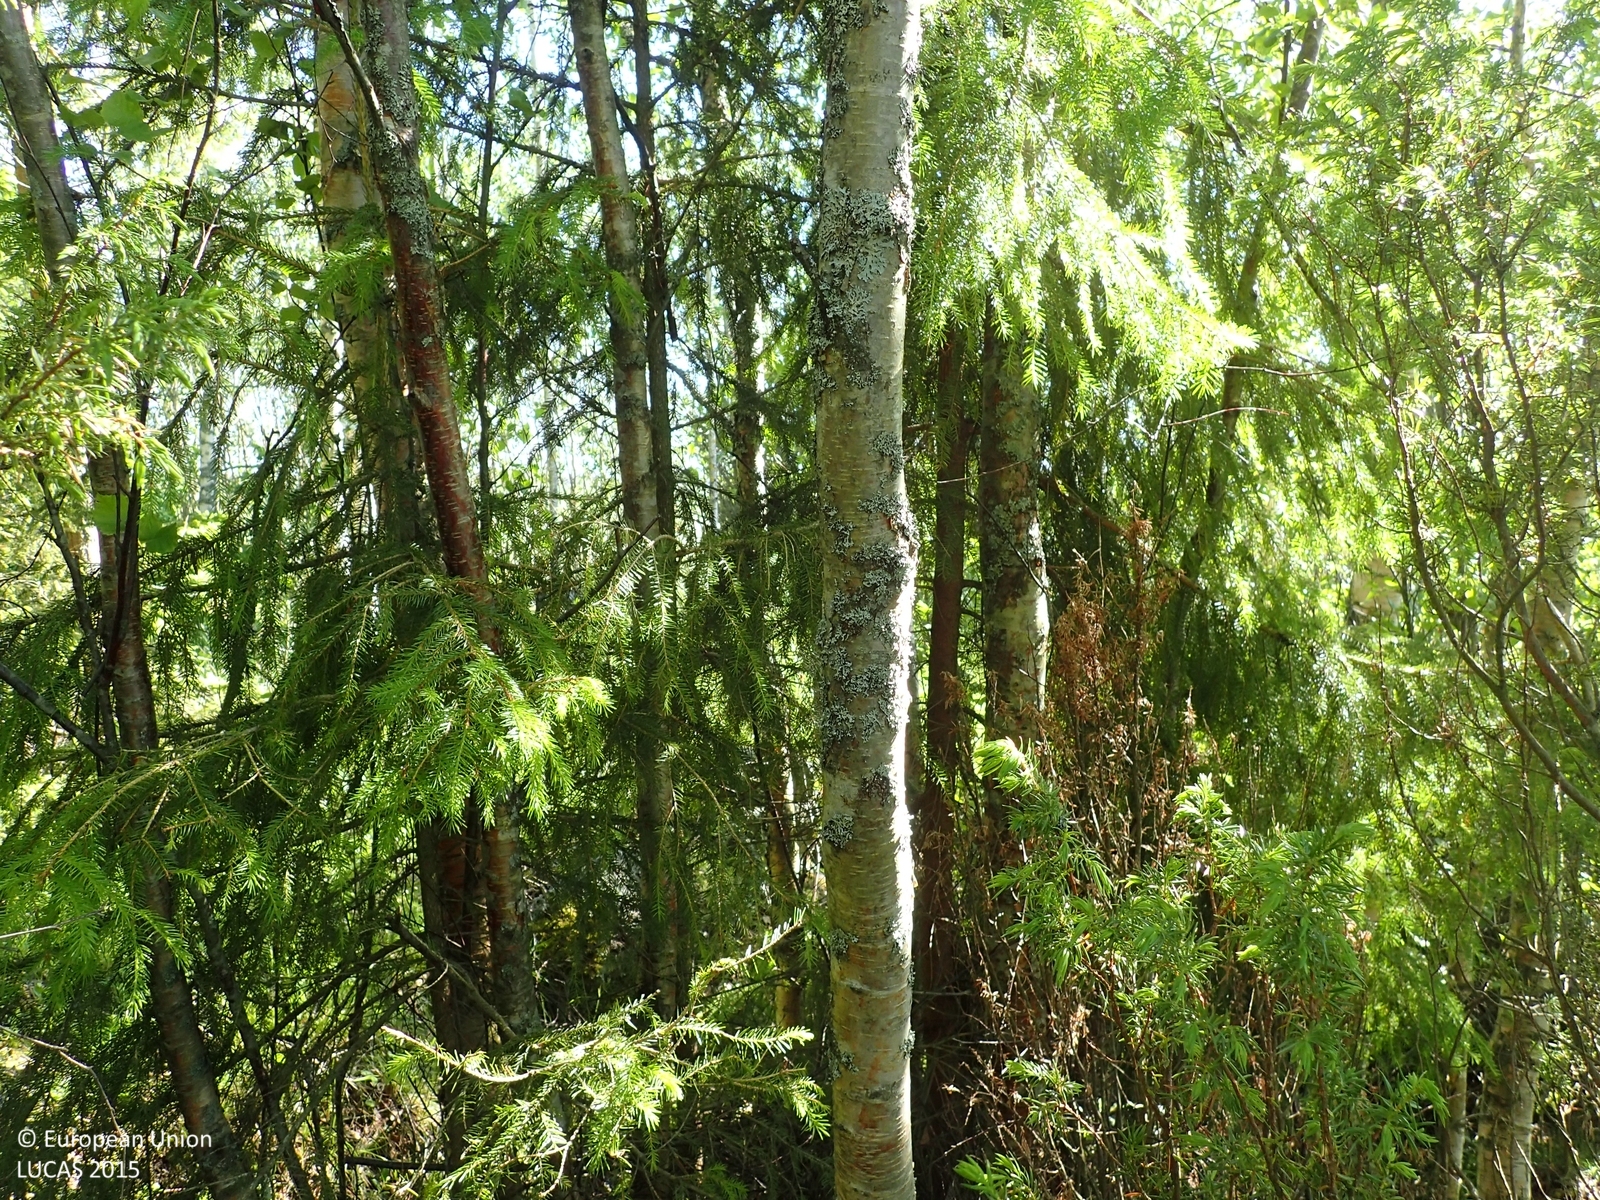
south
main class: Woodland
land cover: Other mixed woodland
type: boreal forest
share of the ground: > 75 %
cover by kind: coniferous forest trees 60 %, broadleaved forest trees 20 %, shrubs 15 %, herbaceous plants 5 %
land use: Forestry
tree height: > 5 m
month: June
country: FI
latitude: 62.4797
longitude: 21.2733
